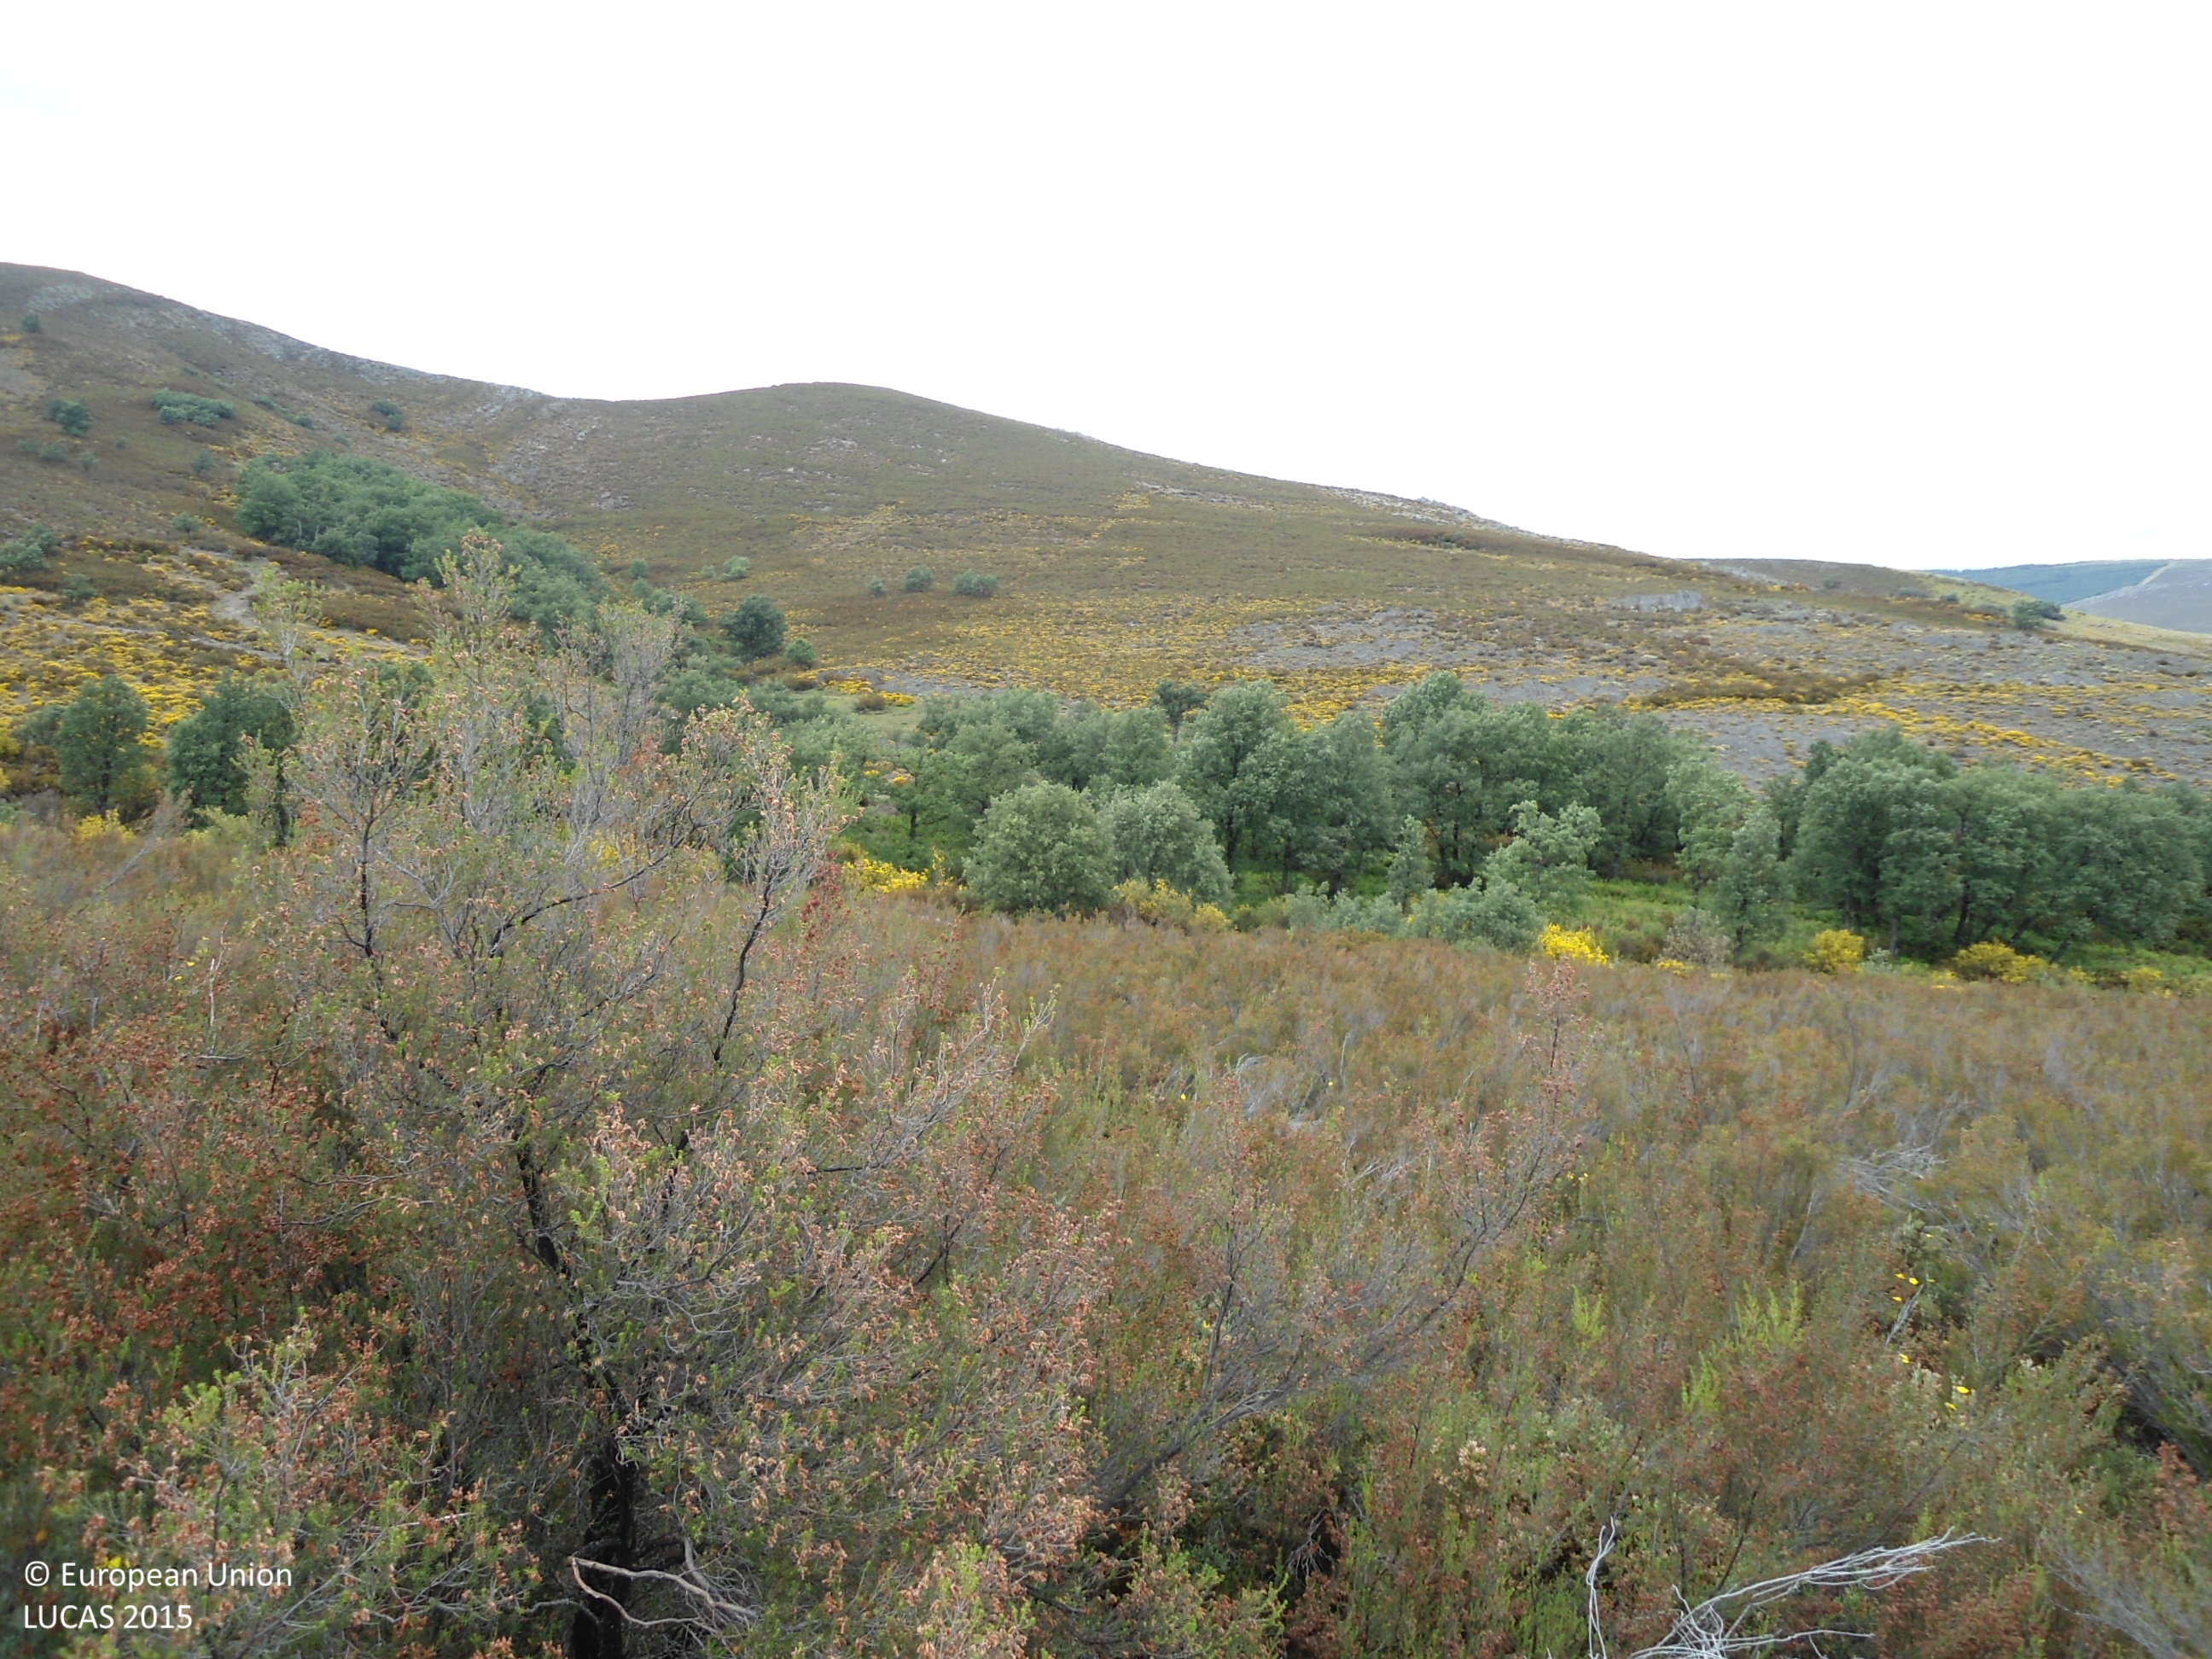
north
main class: Woodland
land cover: Broadleaved woodland
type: floodplain forest
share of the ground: > 75 %
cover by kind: broadleaved forest trees 90 %, shrubs 10 %
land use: Semi-natural and natural areas not in use
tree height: > 5 m
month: June
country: ES
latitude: 42.2114
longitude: -6.3776
